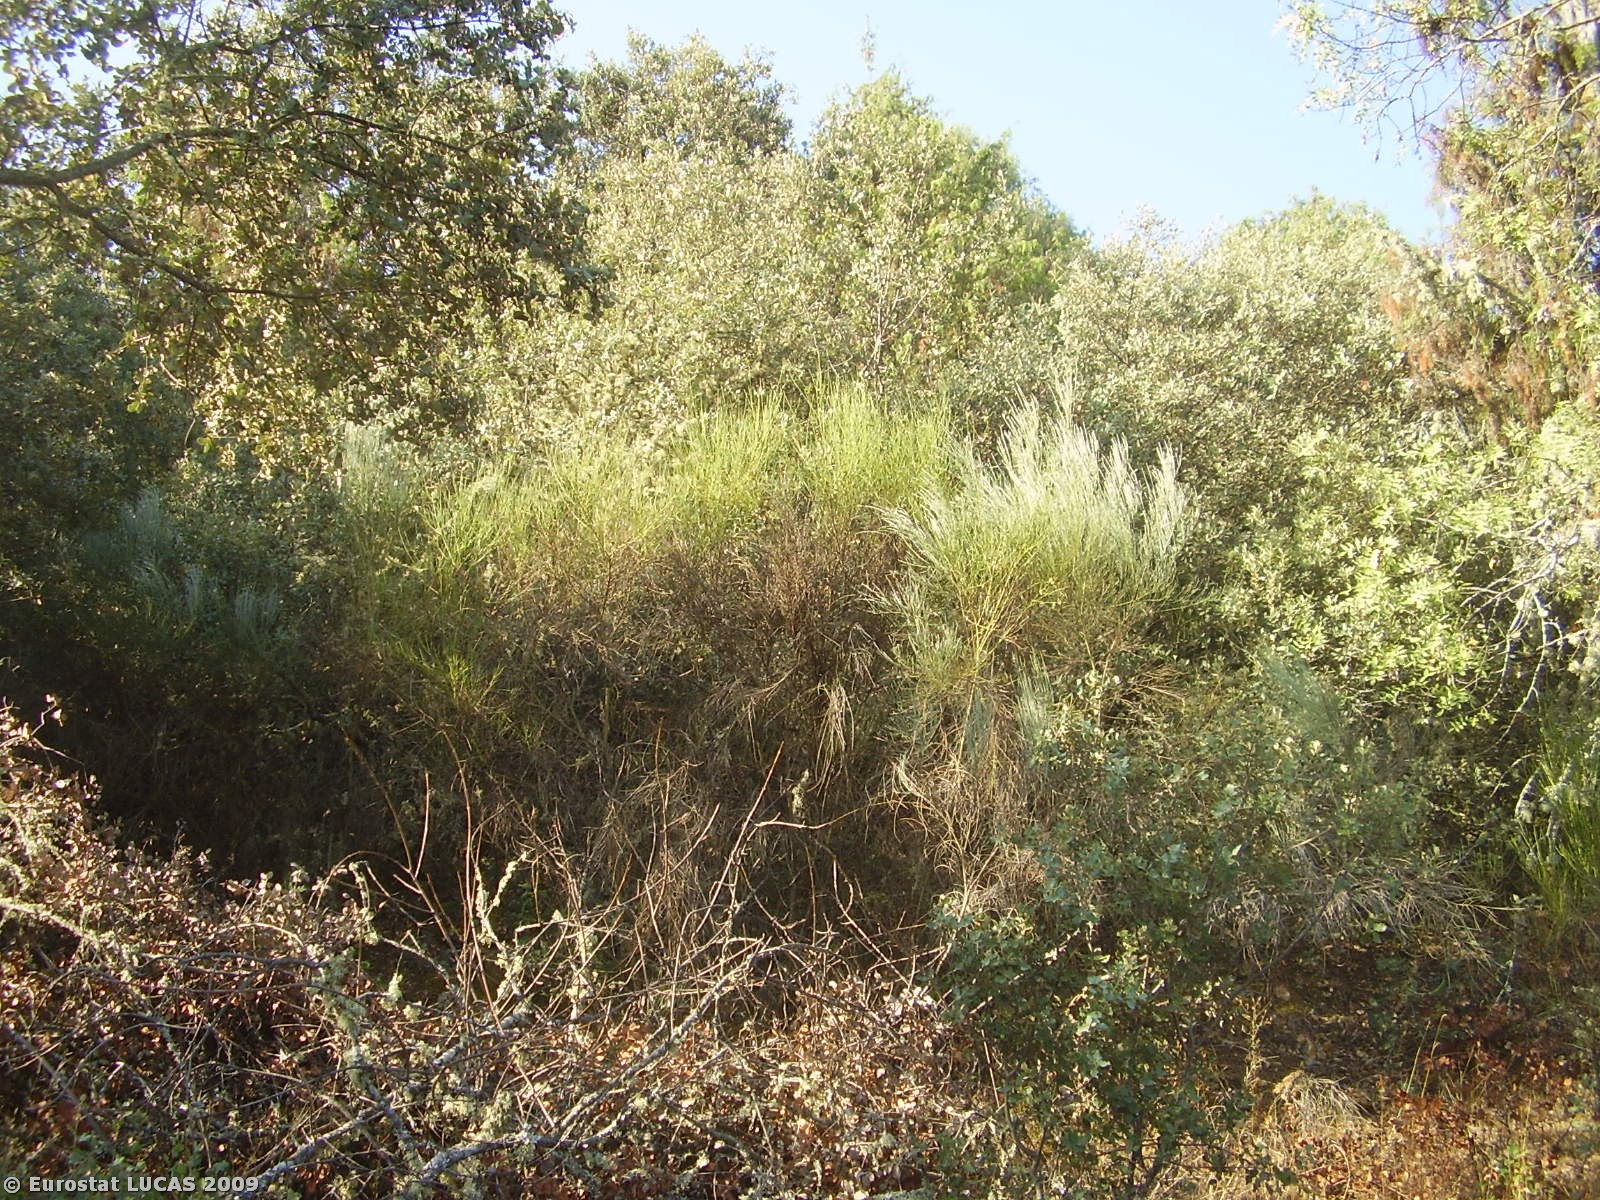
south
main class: Woodland
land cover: Broadleaved woodland
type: broadleaved evergreen forest
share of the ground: 10 - 25 %
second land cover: Spontaneously vegetated surfaces
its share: > 75 %
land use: Forestry
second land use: Fallow land
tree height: > 5 m
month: August
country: PT
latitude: 41.3879
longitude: -6.7904
